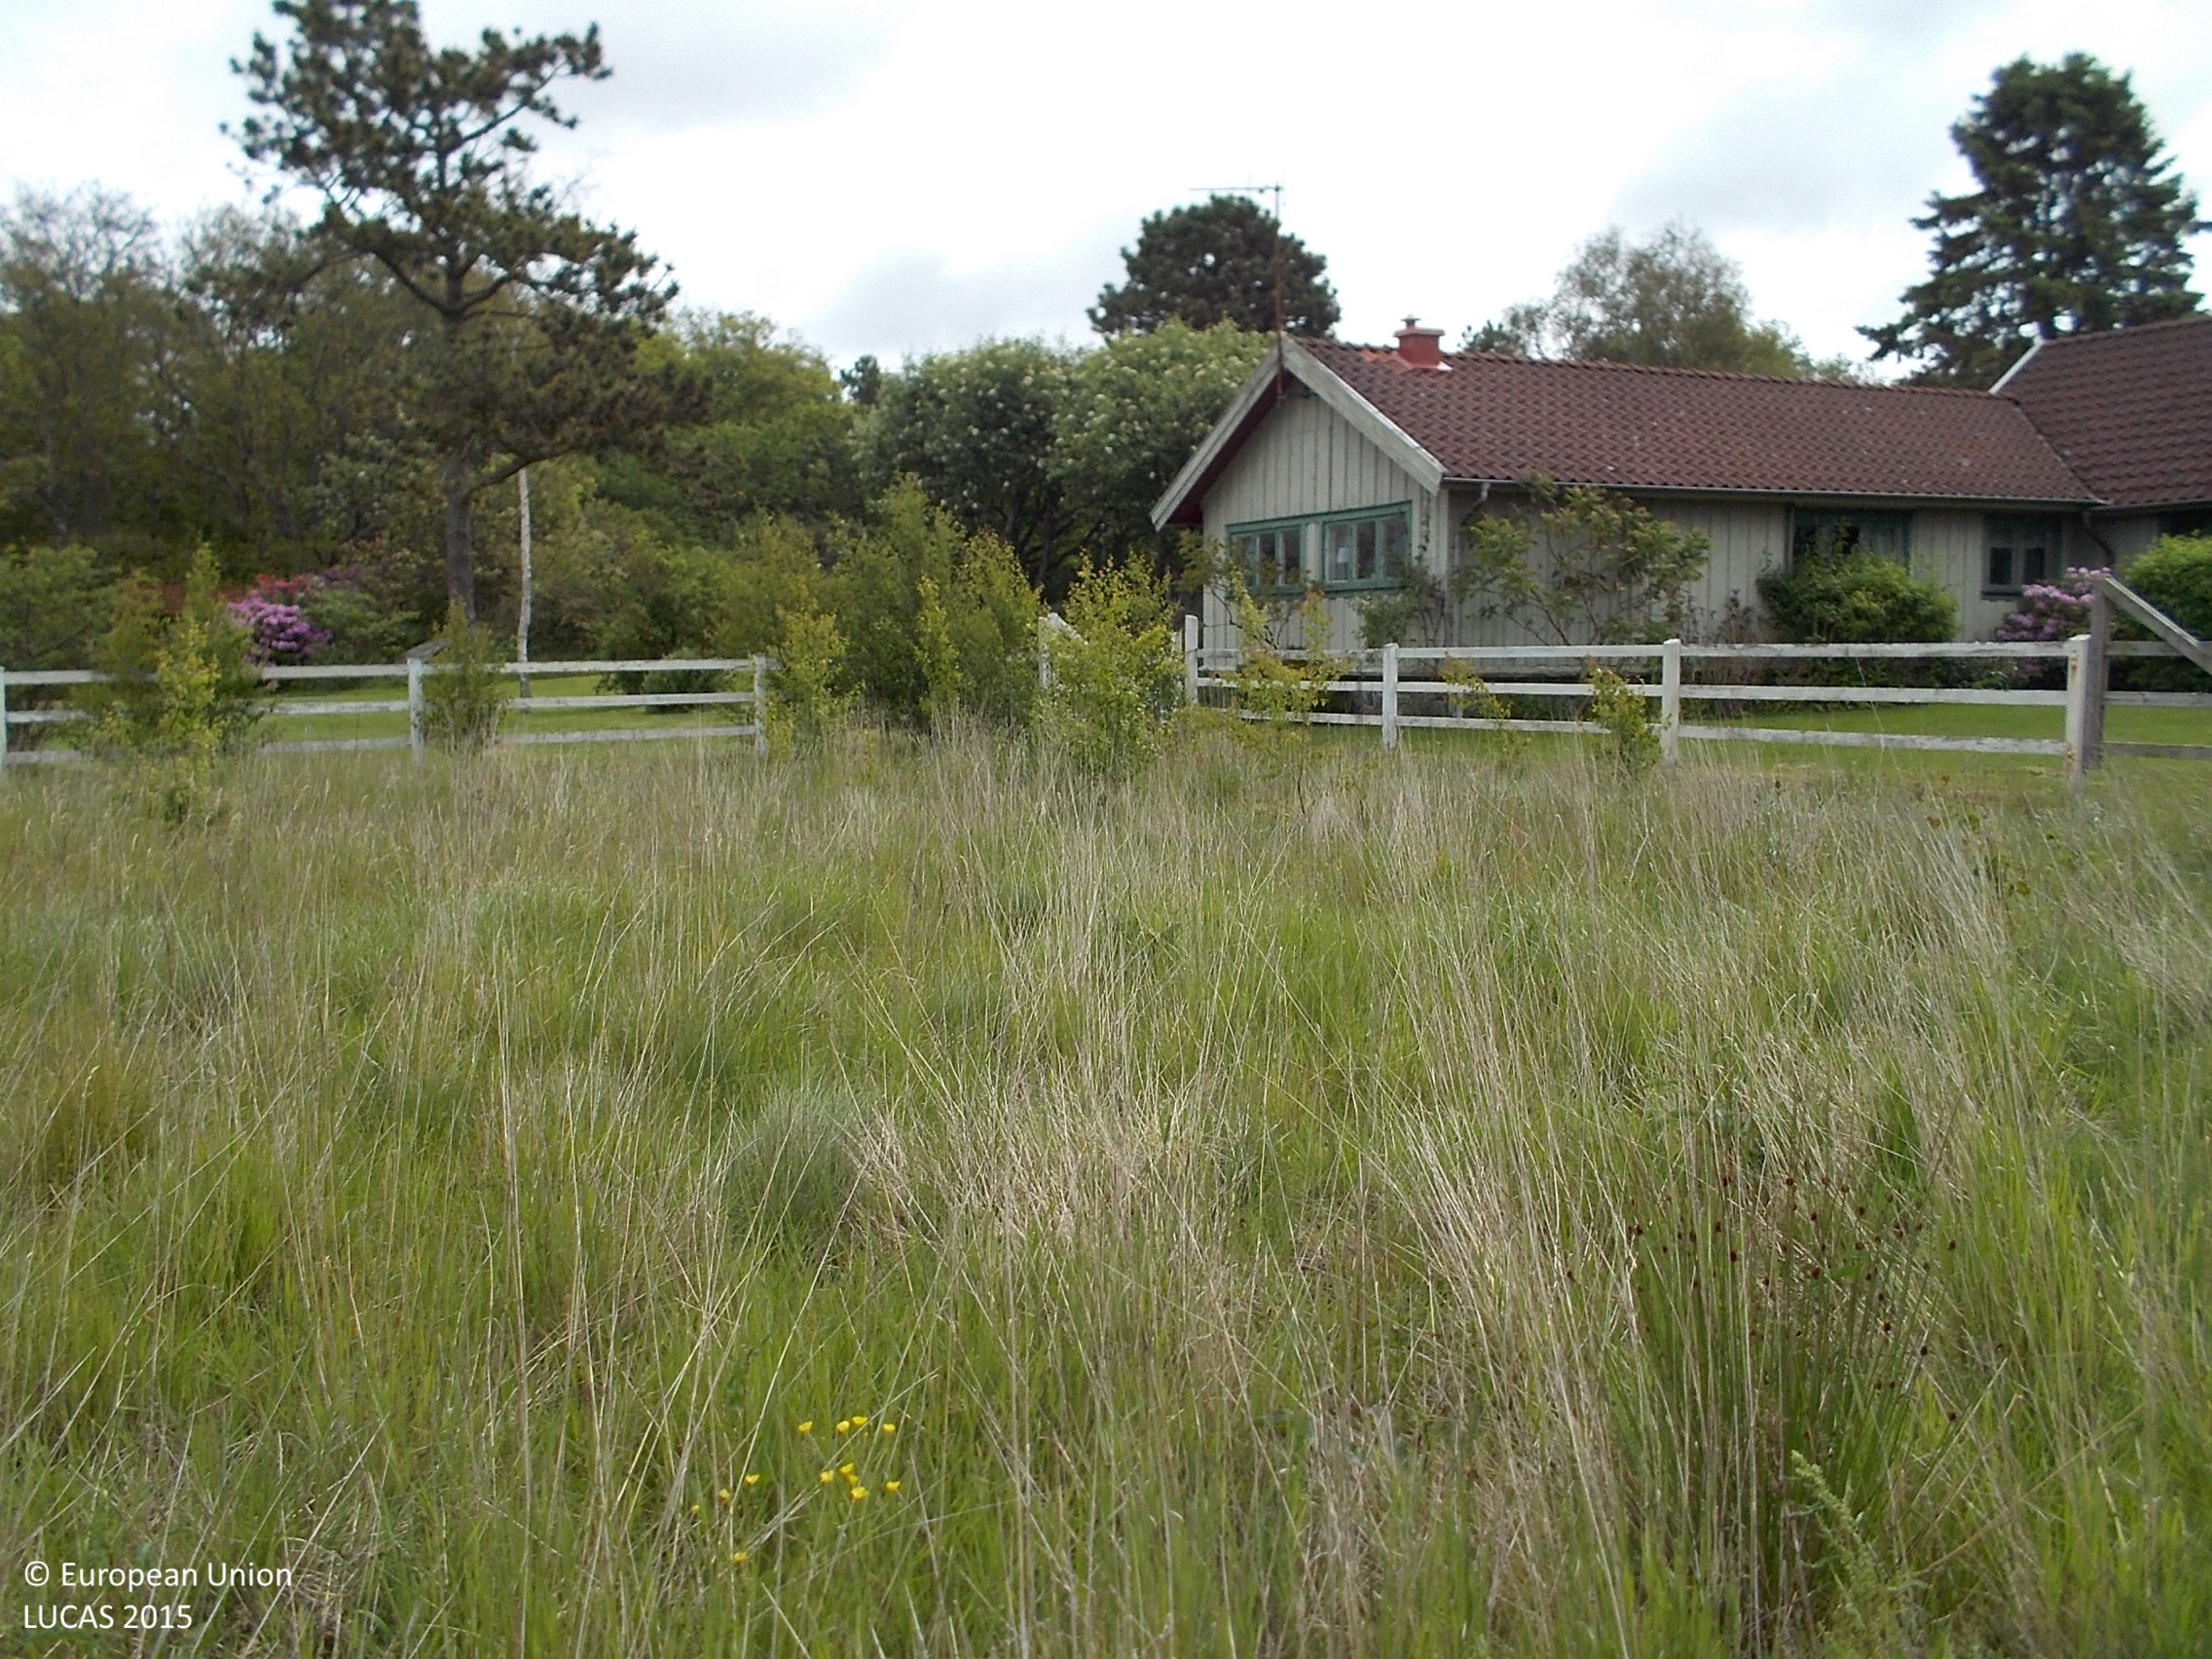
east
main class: Grassland
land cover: Grassland with sparse tree/shrub cover
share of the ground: > 75 %
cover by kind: herbaceous plants 90 %, broadleaved forest trees 5 %, shrubs 5 %
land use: Abandoned areas
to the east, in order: Grassland with sparse tree/shrub cover; Artificial constructions in urban areas; Pine dominated mixed woodland; Tracks; Broadleaved woodland; Tracks; Broadleaved woodland; Dry stone walls; Grassland without tree/shrub cover
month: June
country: SE
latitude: 57.3959
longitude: 11.9439
